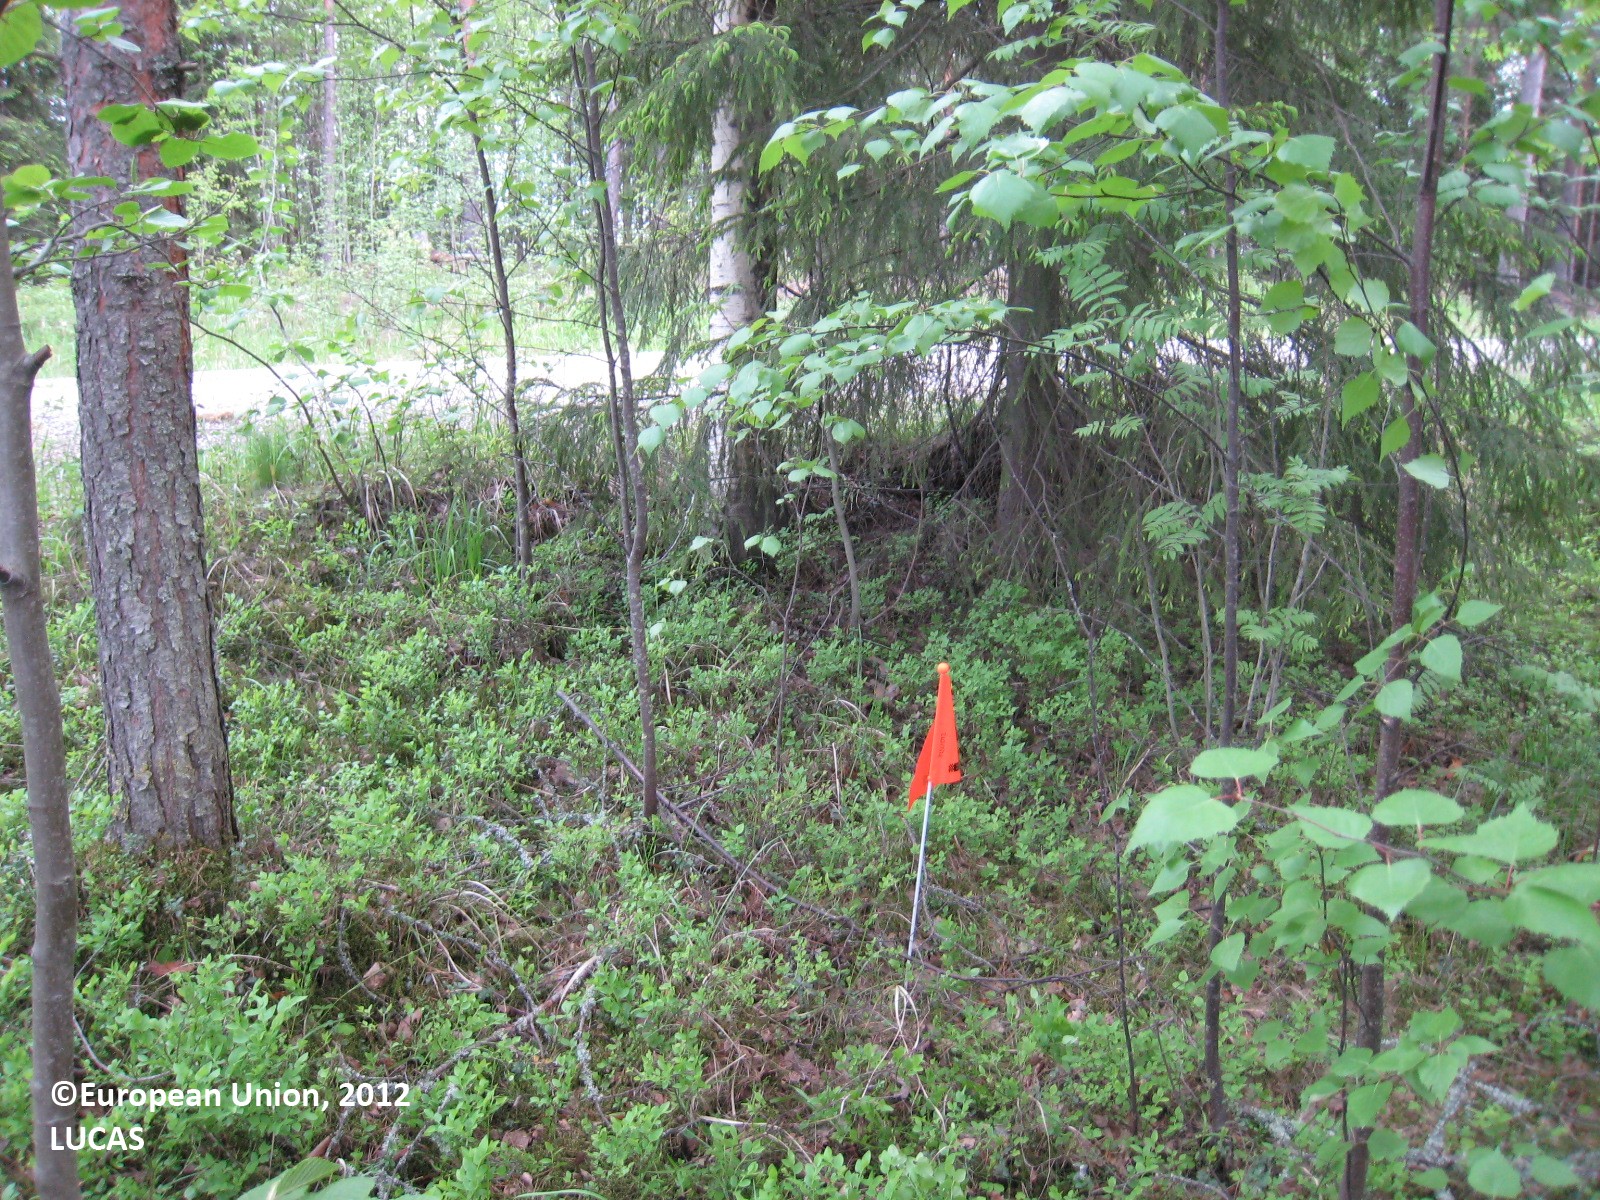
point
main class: Woodland
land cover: Pine dominated mixed woodland
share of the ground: > 75 %
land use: Forestry
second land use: Road transport
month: June
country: FI
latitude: 62.6118
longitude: 26.0438
